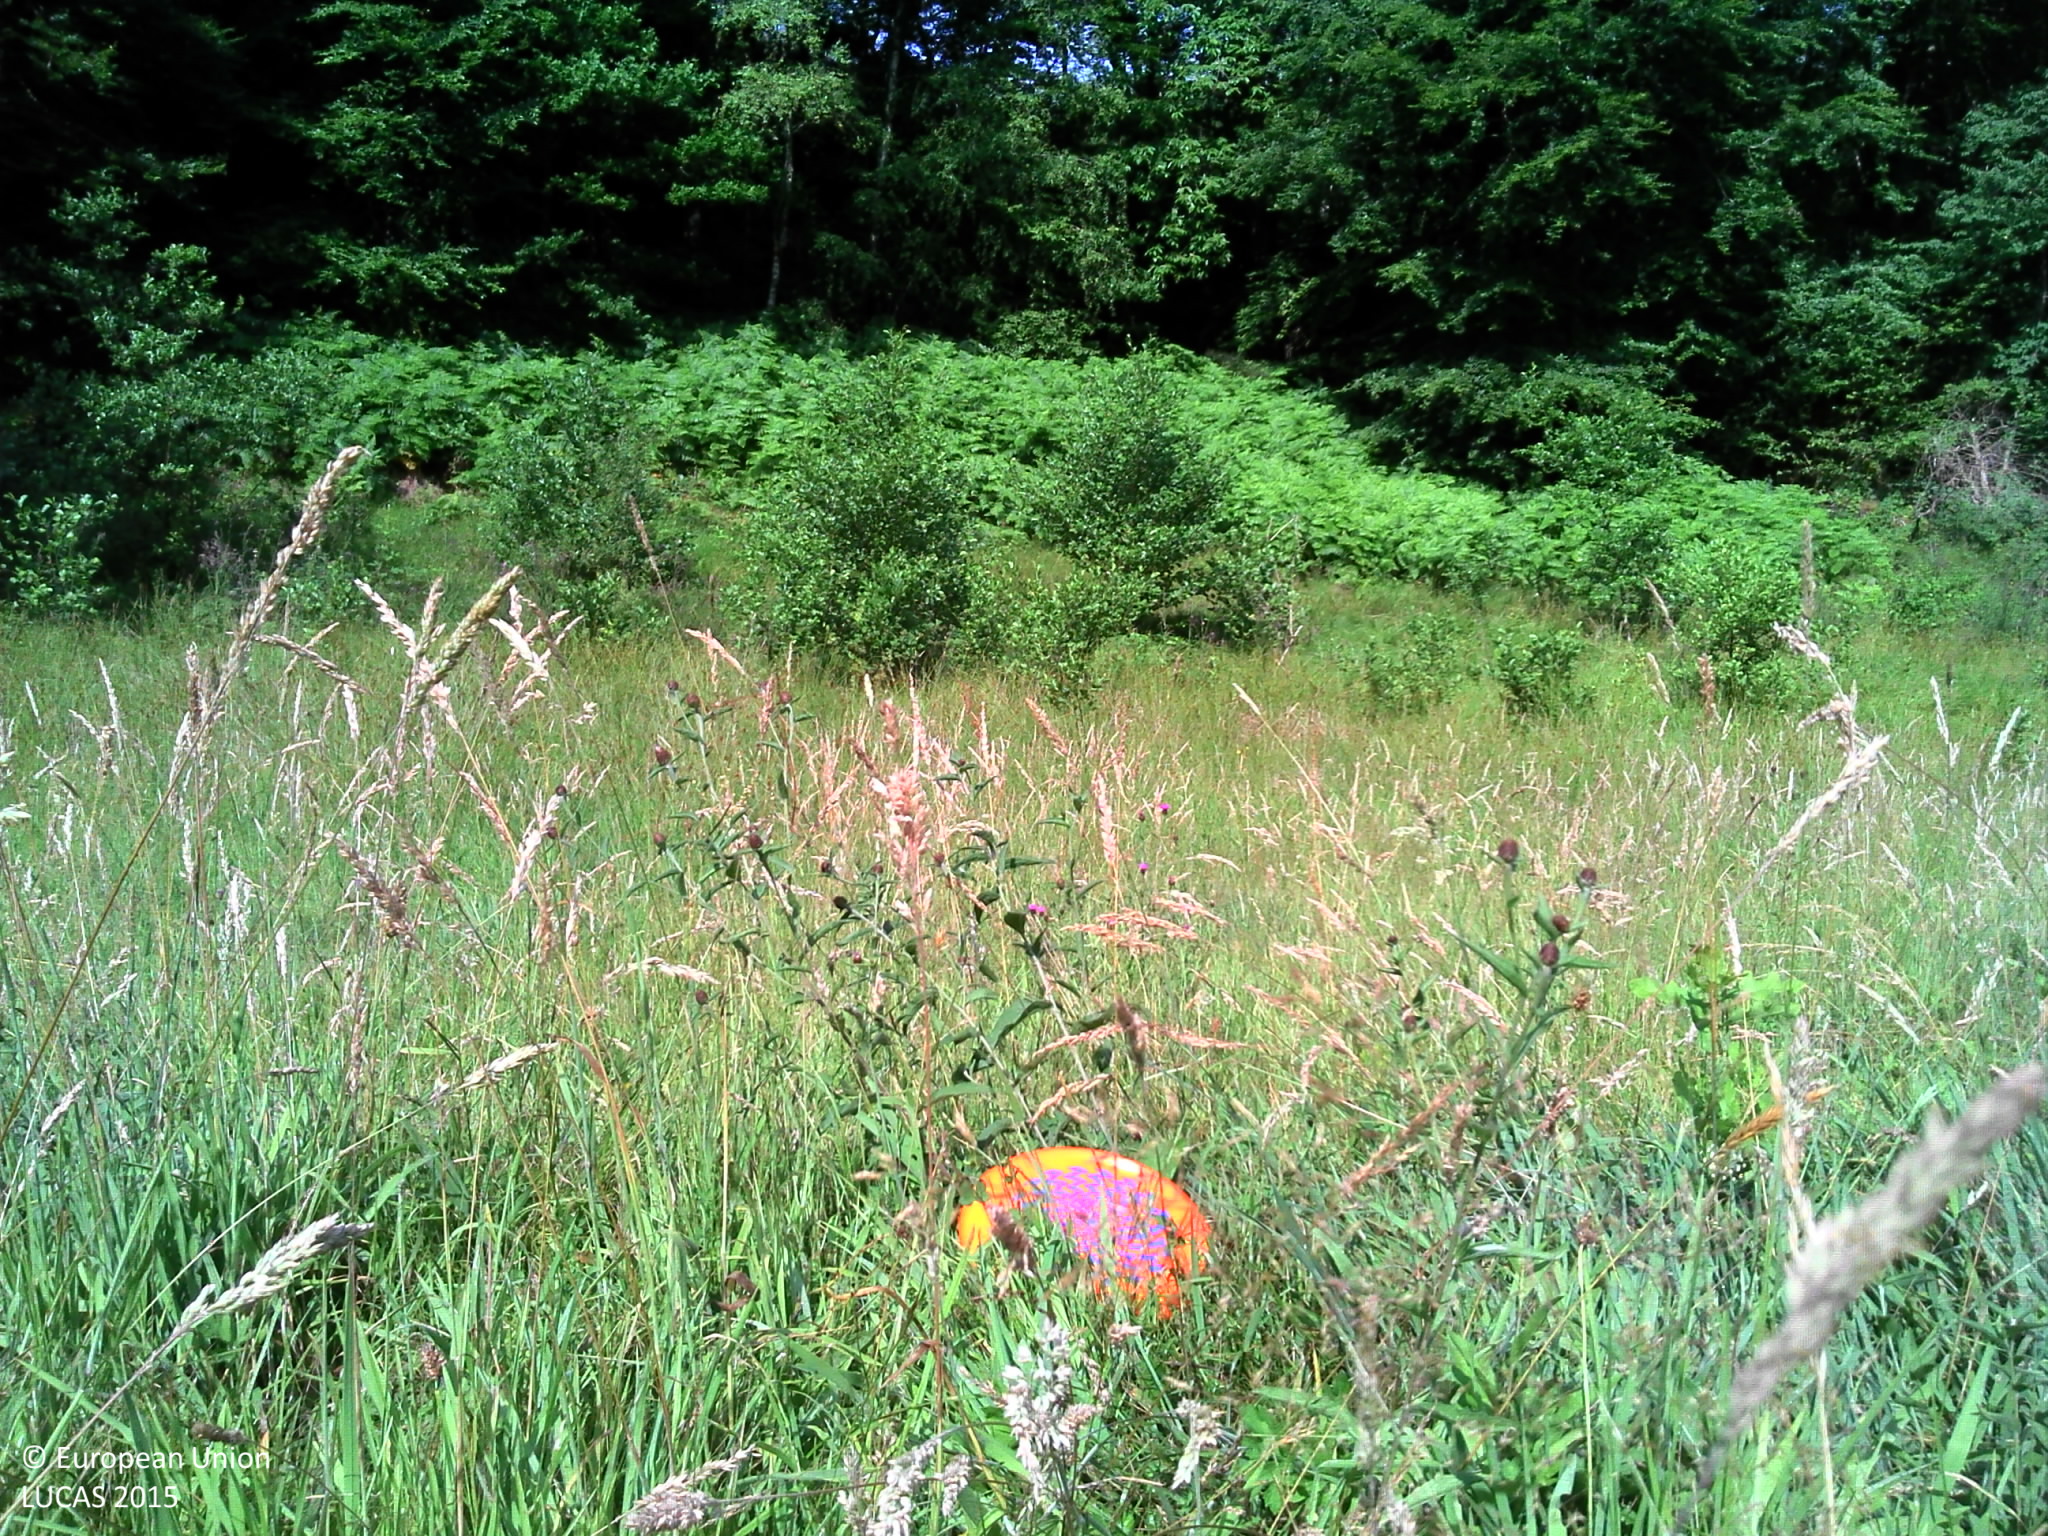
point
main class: Grassland
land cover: Grassland without tree/shrub cover
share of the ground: > 75 %
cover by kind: herbaceous plants 100 %
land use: Agriculture (excluding fallow land and kitchen gardens)
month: July
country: FR
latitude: 45.8005
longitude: 1.7982
